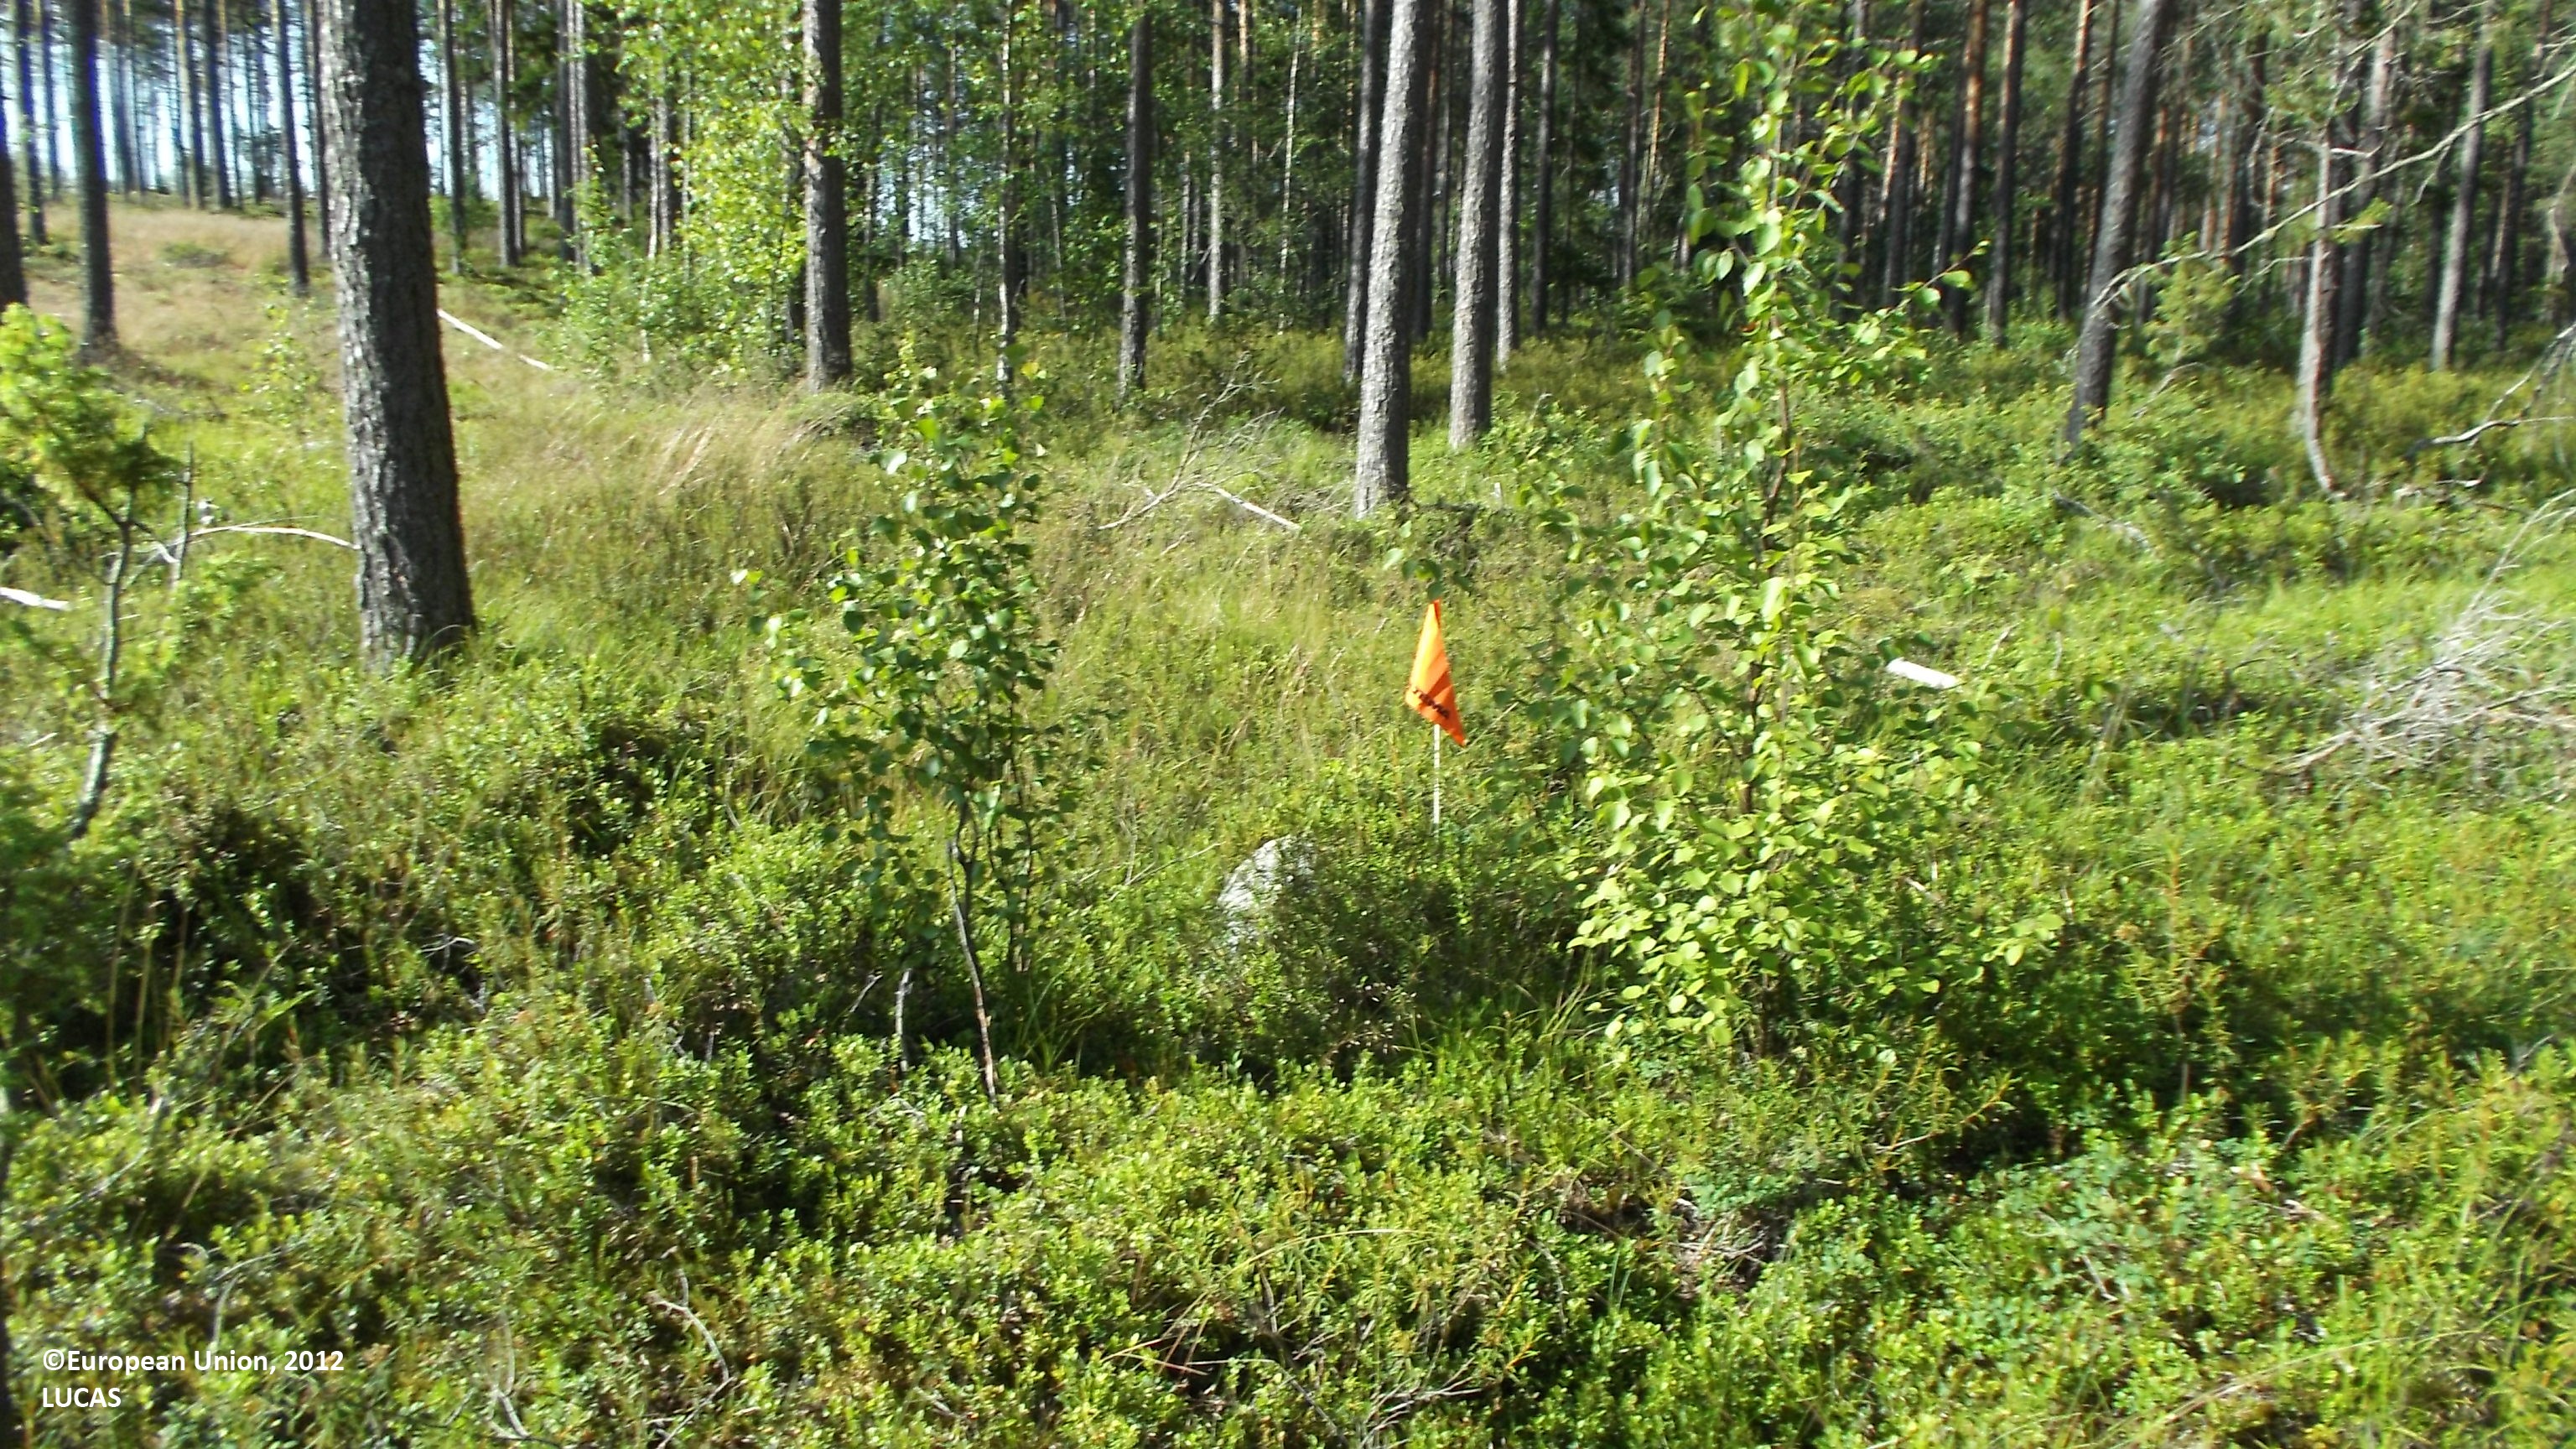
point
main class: Woodland
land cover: Pine dominated coniferous woodland
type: boreal forest
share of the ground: 25 - 50 %
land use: Forestry
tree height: > 5 m
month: July
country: FI
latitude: 63.7172
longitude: 23.8090
